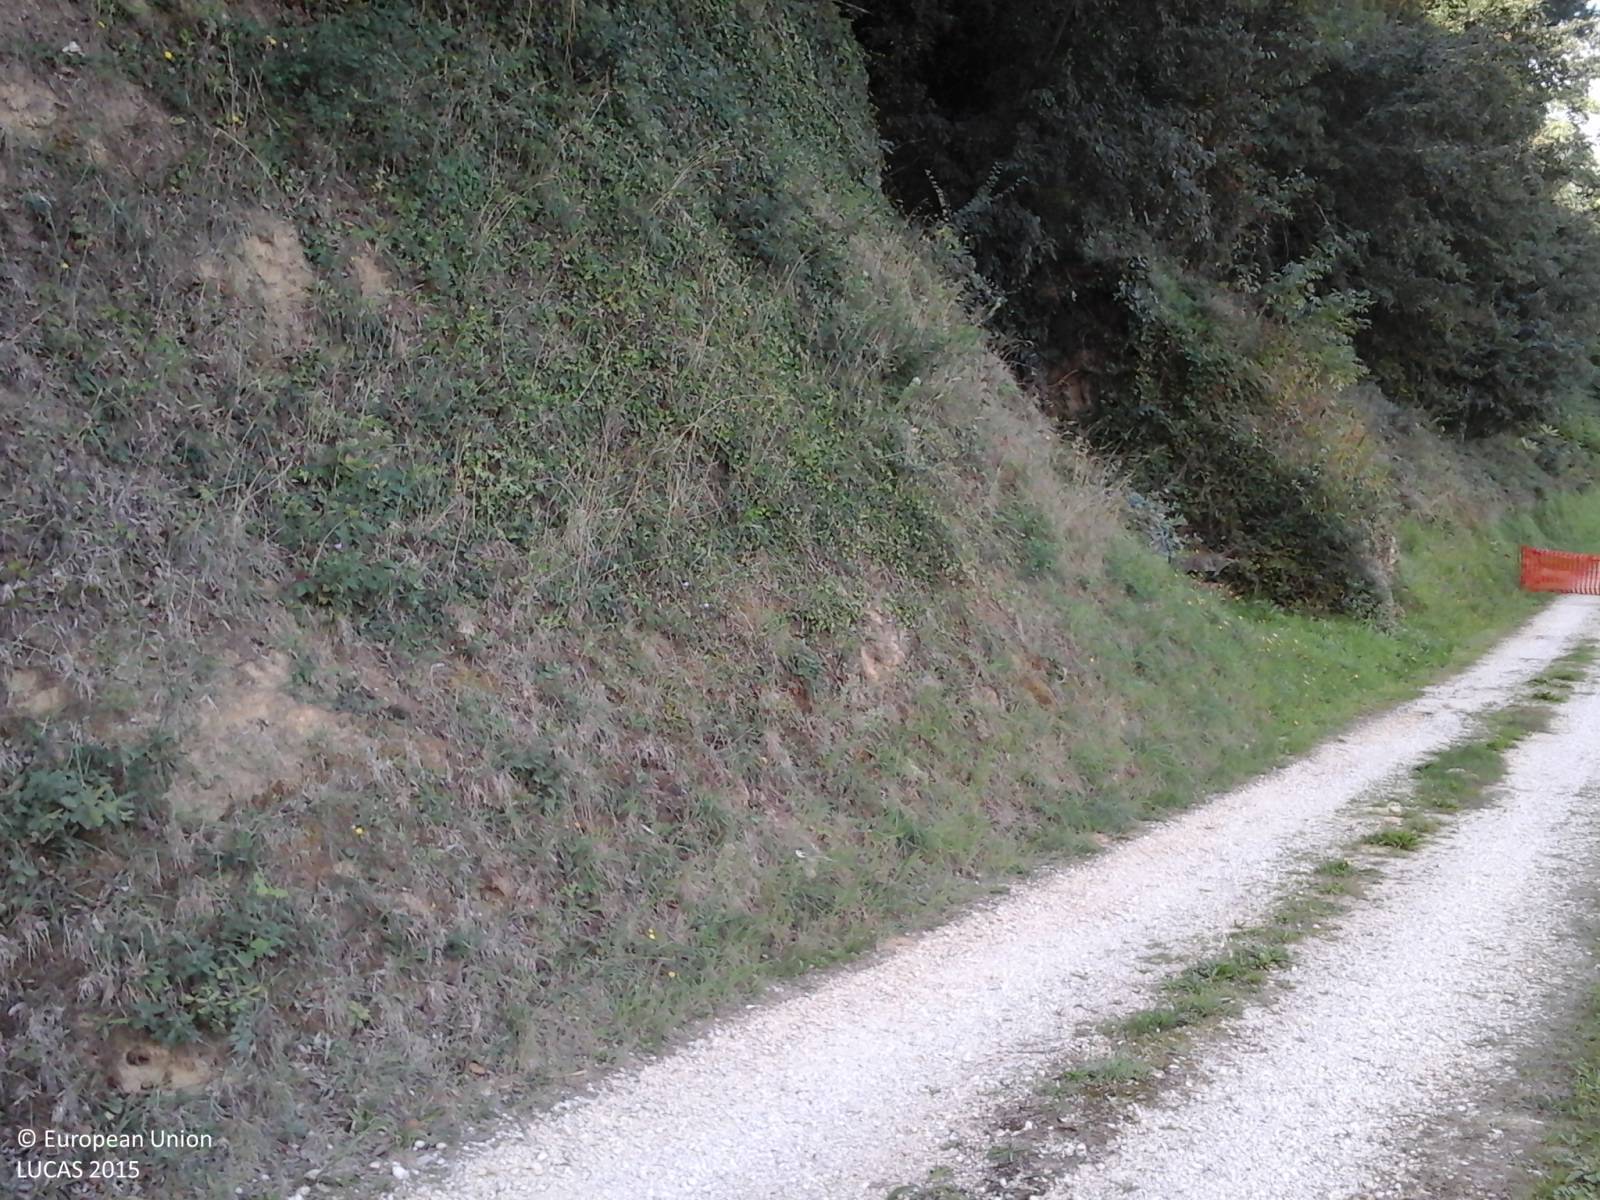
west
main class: Cropland
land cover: Olive groves
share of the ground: 50 - 75 %
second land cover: Spontaneously vegetated surfaces
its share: > 75 %
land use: Kitchen garden
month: September
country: IT
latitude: 42.2599
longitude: 12.5732
